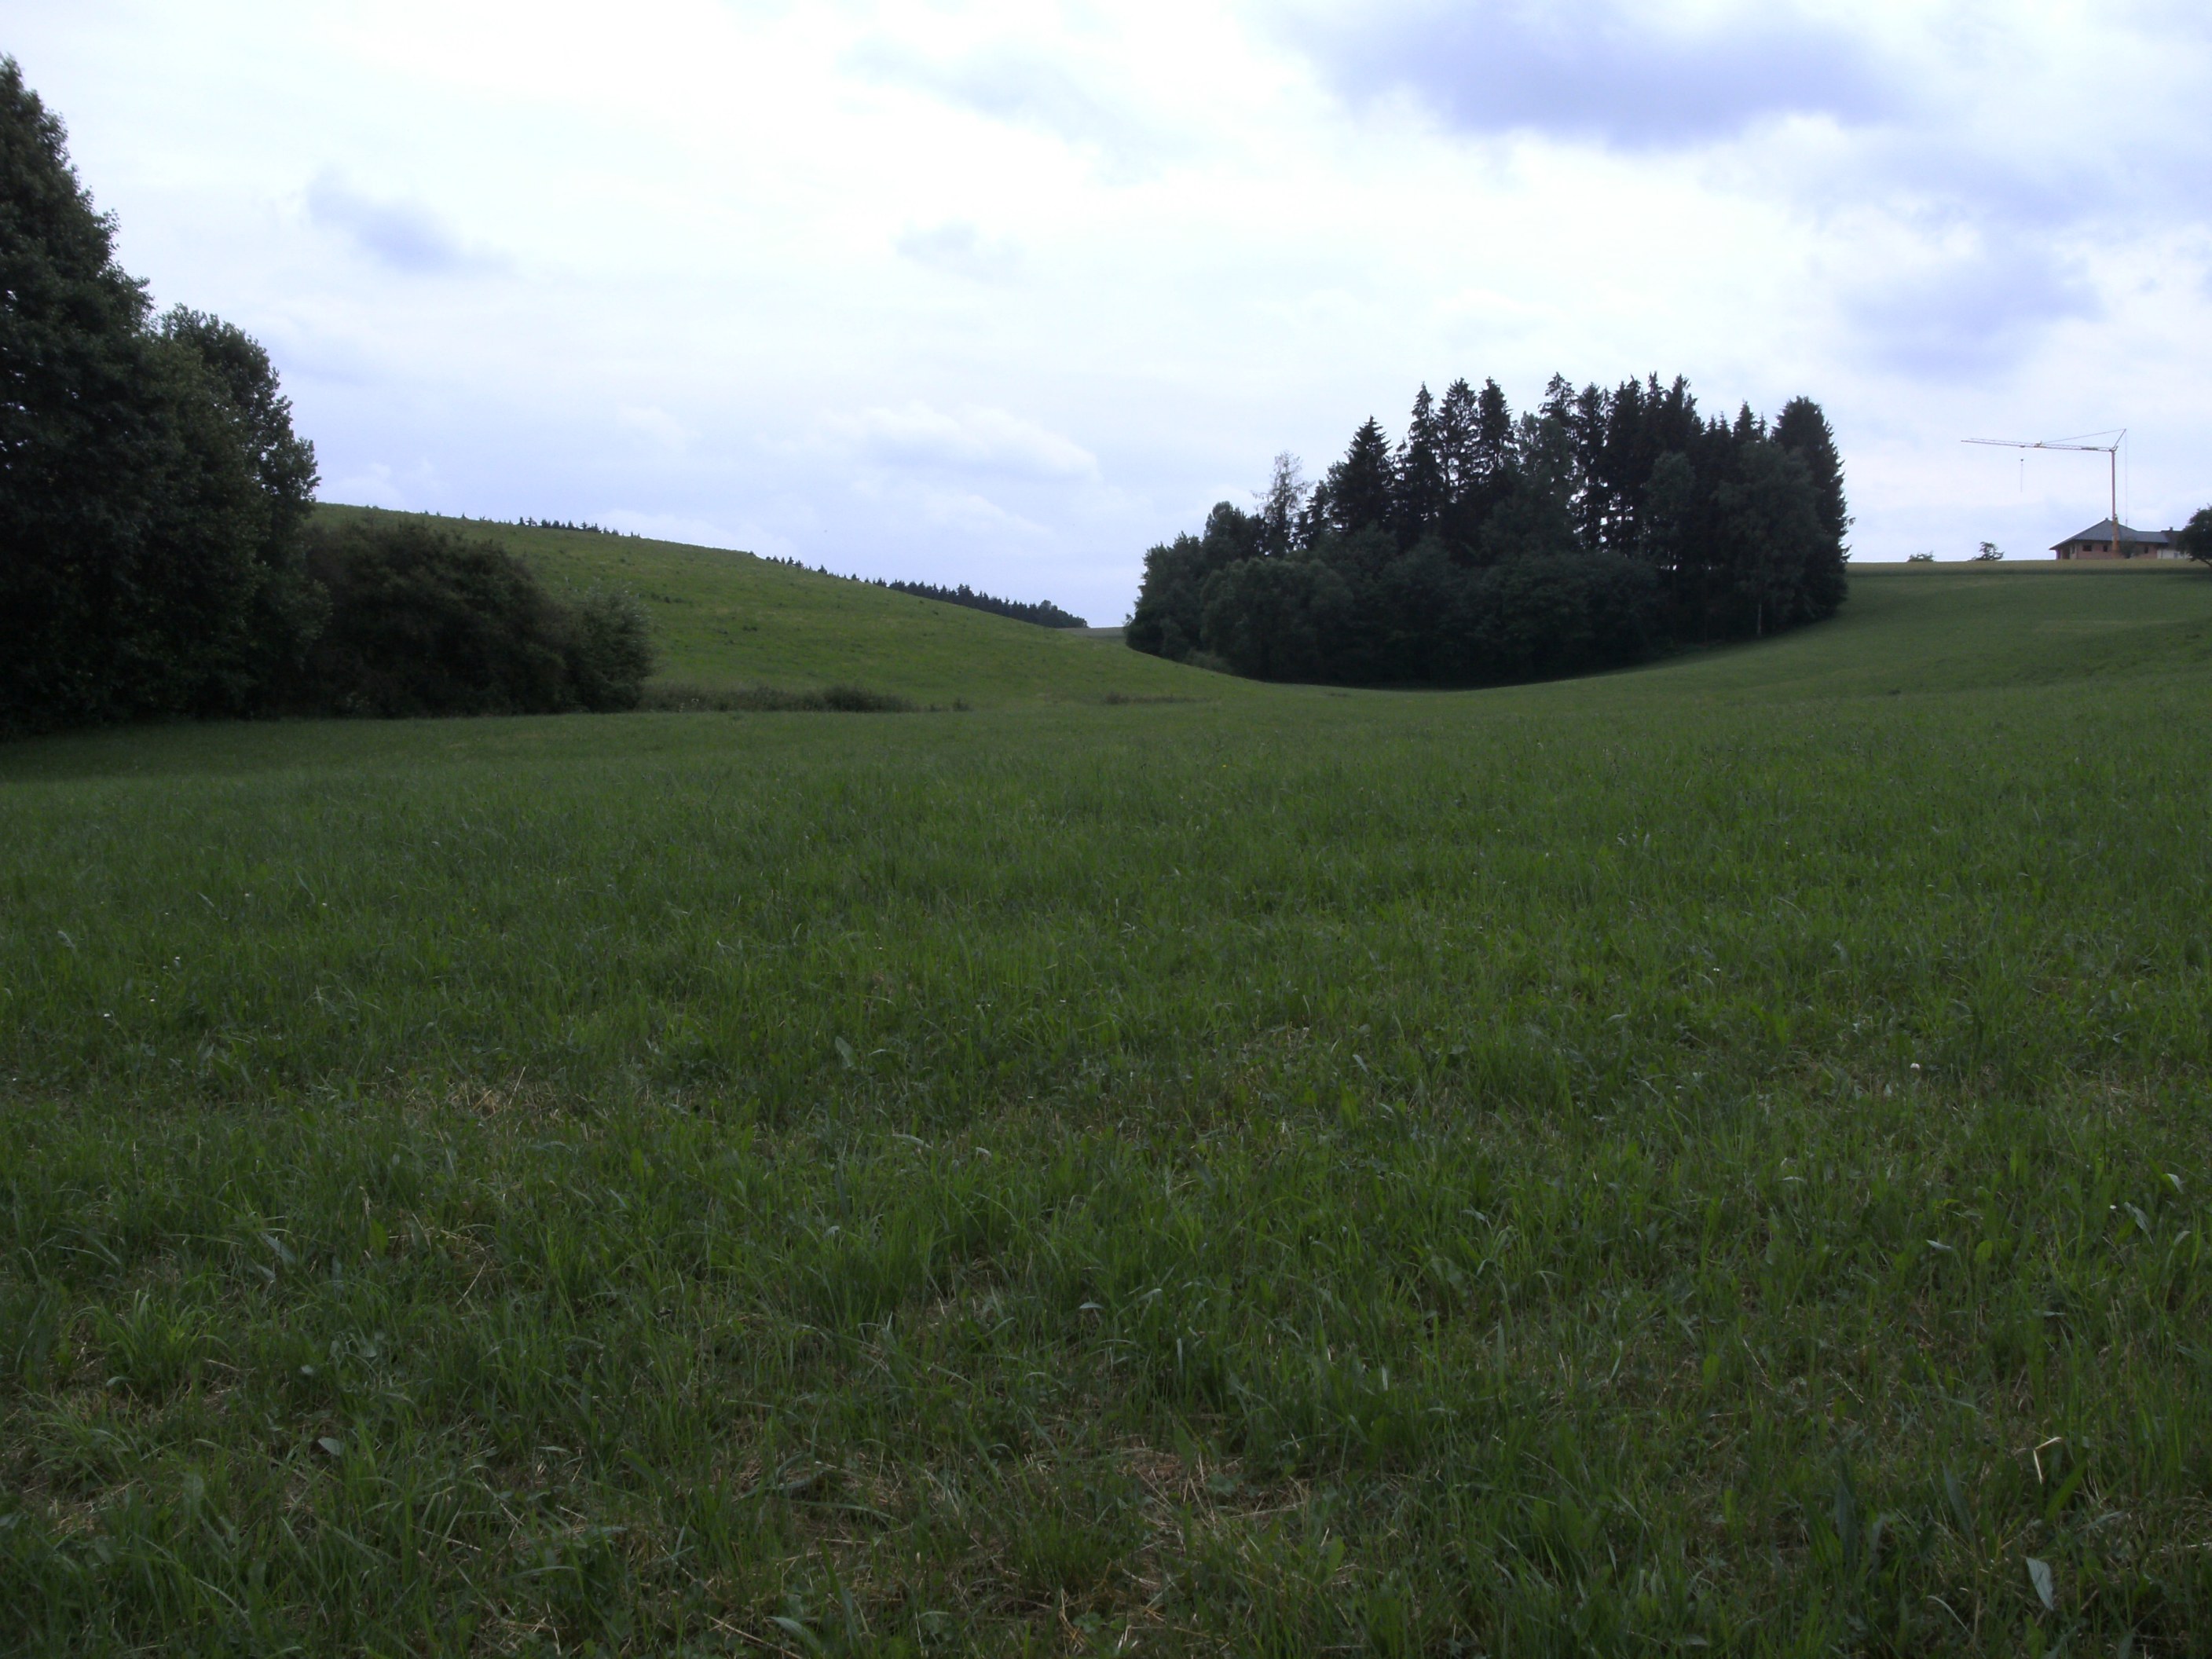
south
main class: Grassland
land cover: Grassland without tree/shrub cover
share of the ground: > 75 %
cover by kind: herbaceous plants 100 %
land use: Agriculture (excluding fallow land and kitchen gardens)
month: June
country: AT
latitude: 48.5096
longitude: 14.0474
